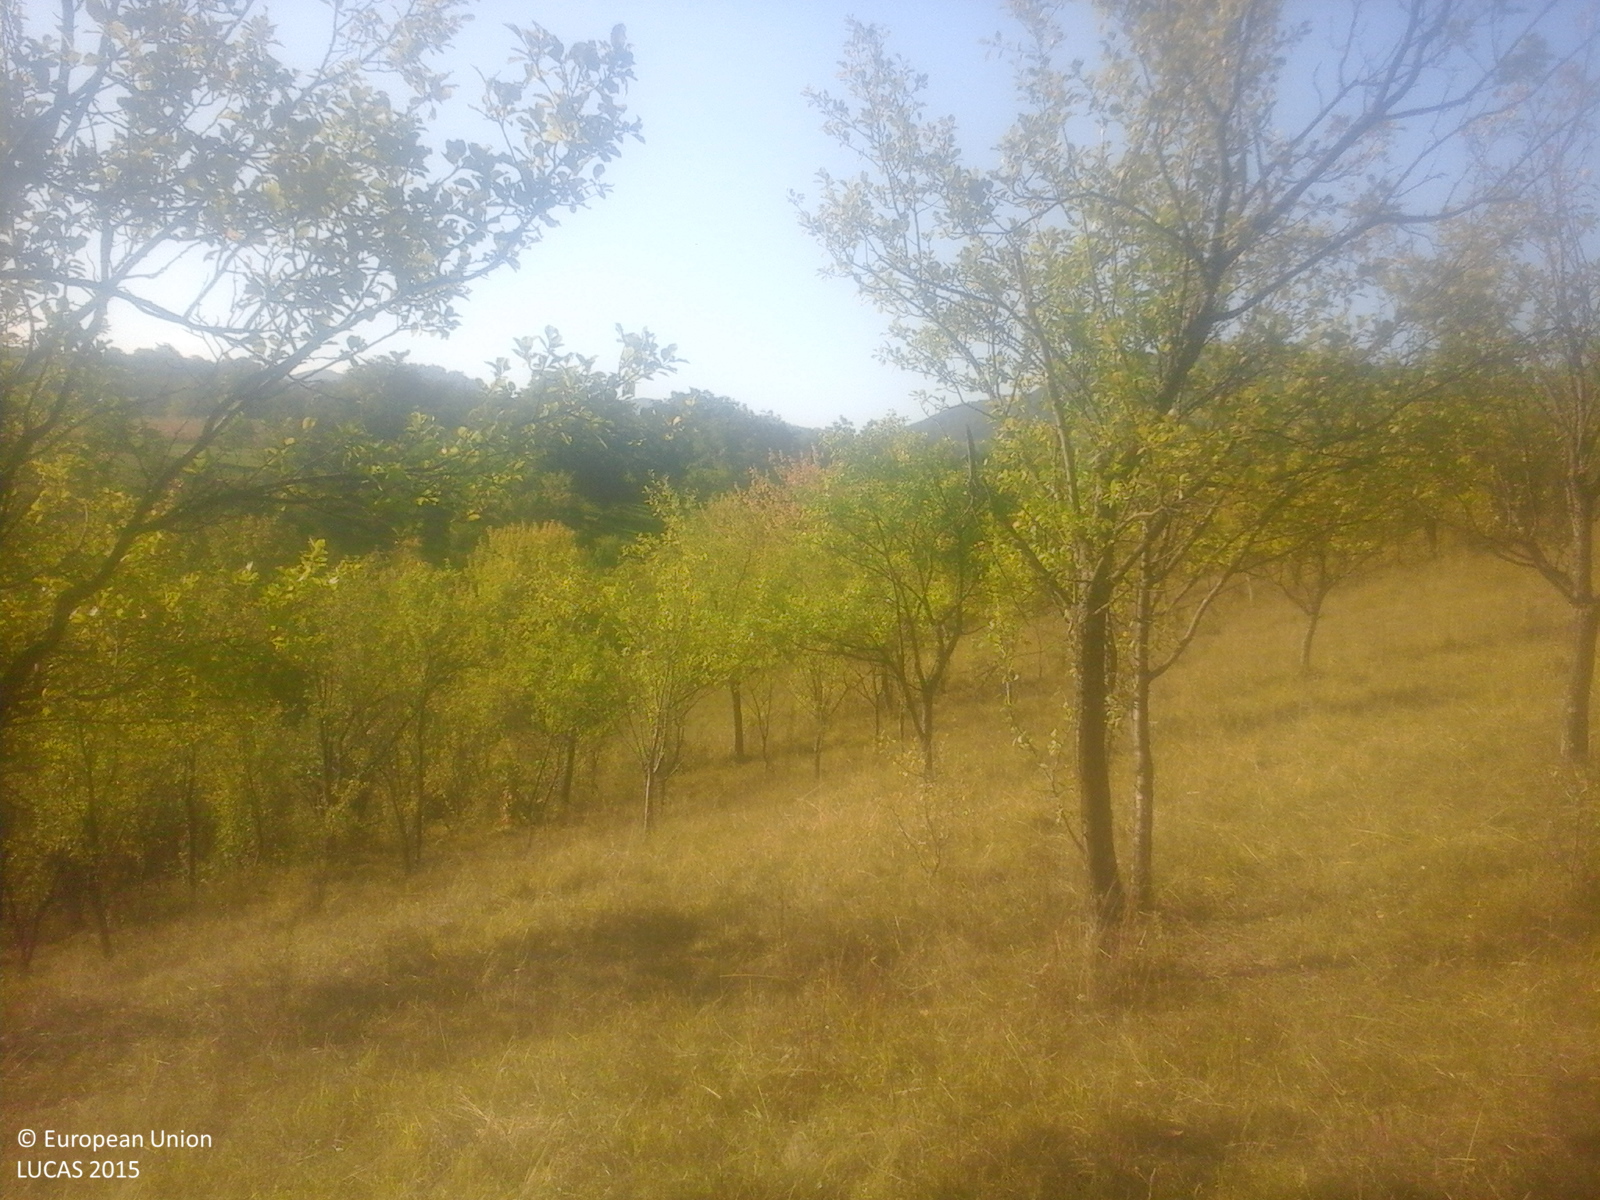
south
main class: Cropland
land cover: Apple fruit
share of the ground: > 75 %
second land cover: Grassland without tree/shrub cover
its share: > 75 %
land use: Agriculture (excluding fallow land and kitchen gardens)
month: September
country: RO
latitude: 46.6527
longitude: 22.1869
